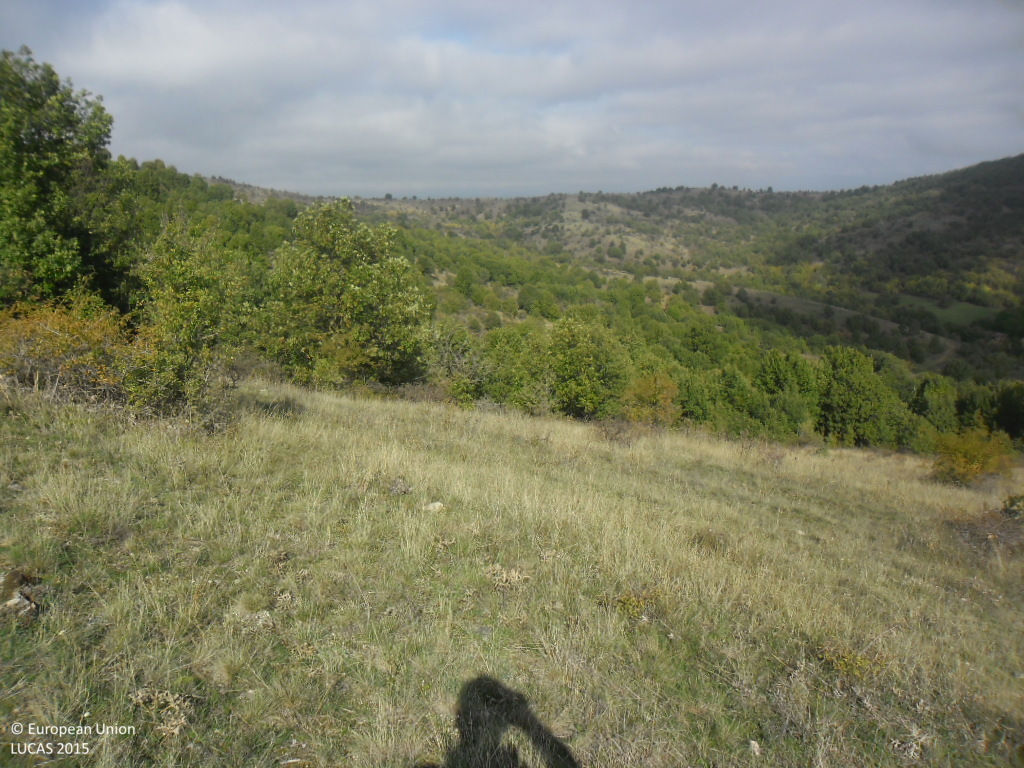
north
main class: Grassland
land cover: Grassland without tree/shrub cover
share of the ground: > 75 %
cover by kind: herbaceous plants 100 %
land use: Agriculture (excluding fallow land and kitchen gardens)
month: October
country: BG
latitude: 41.9323
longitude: 23.0598
